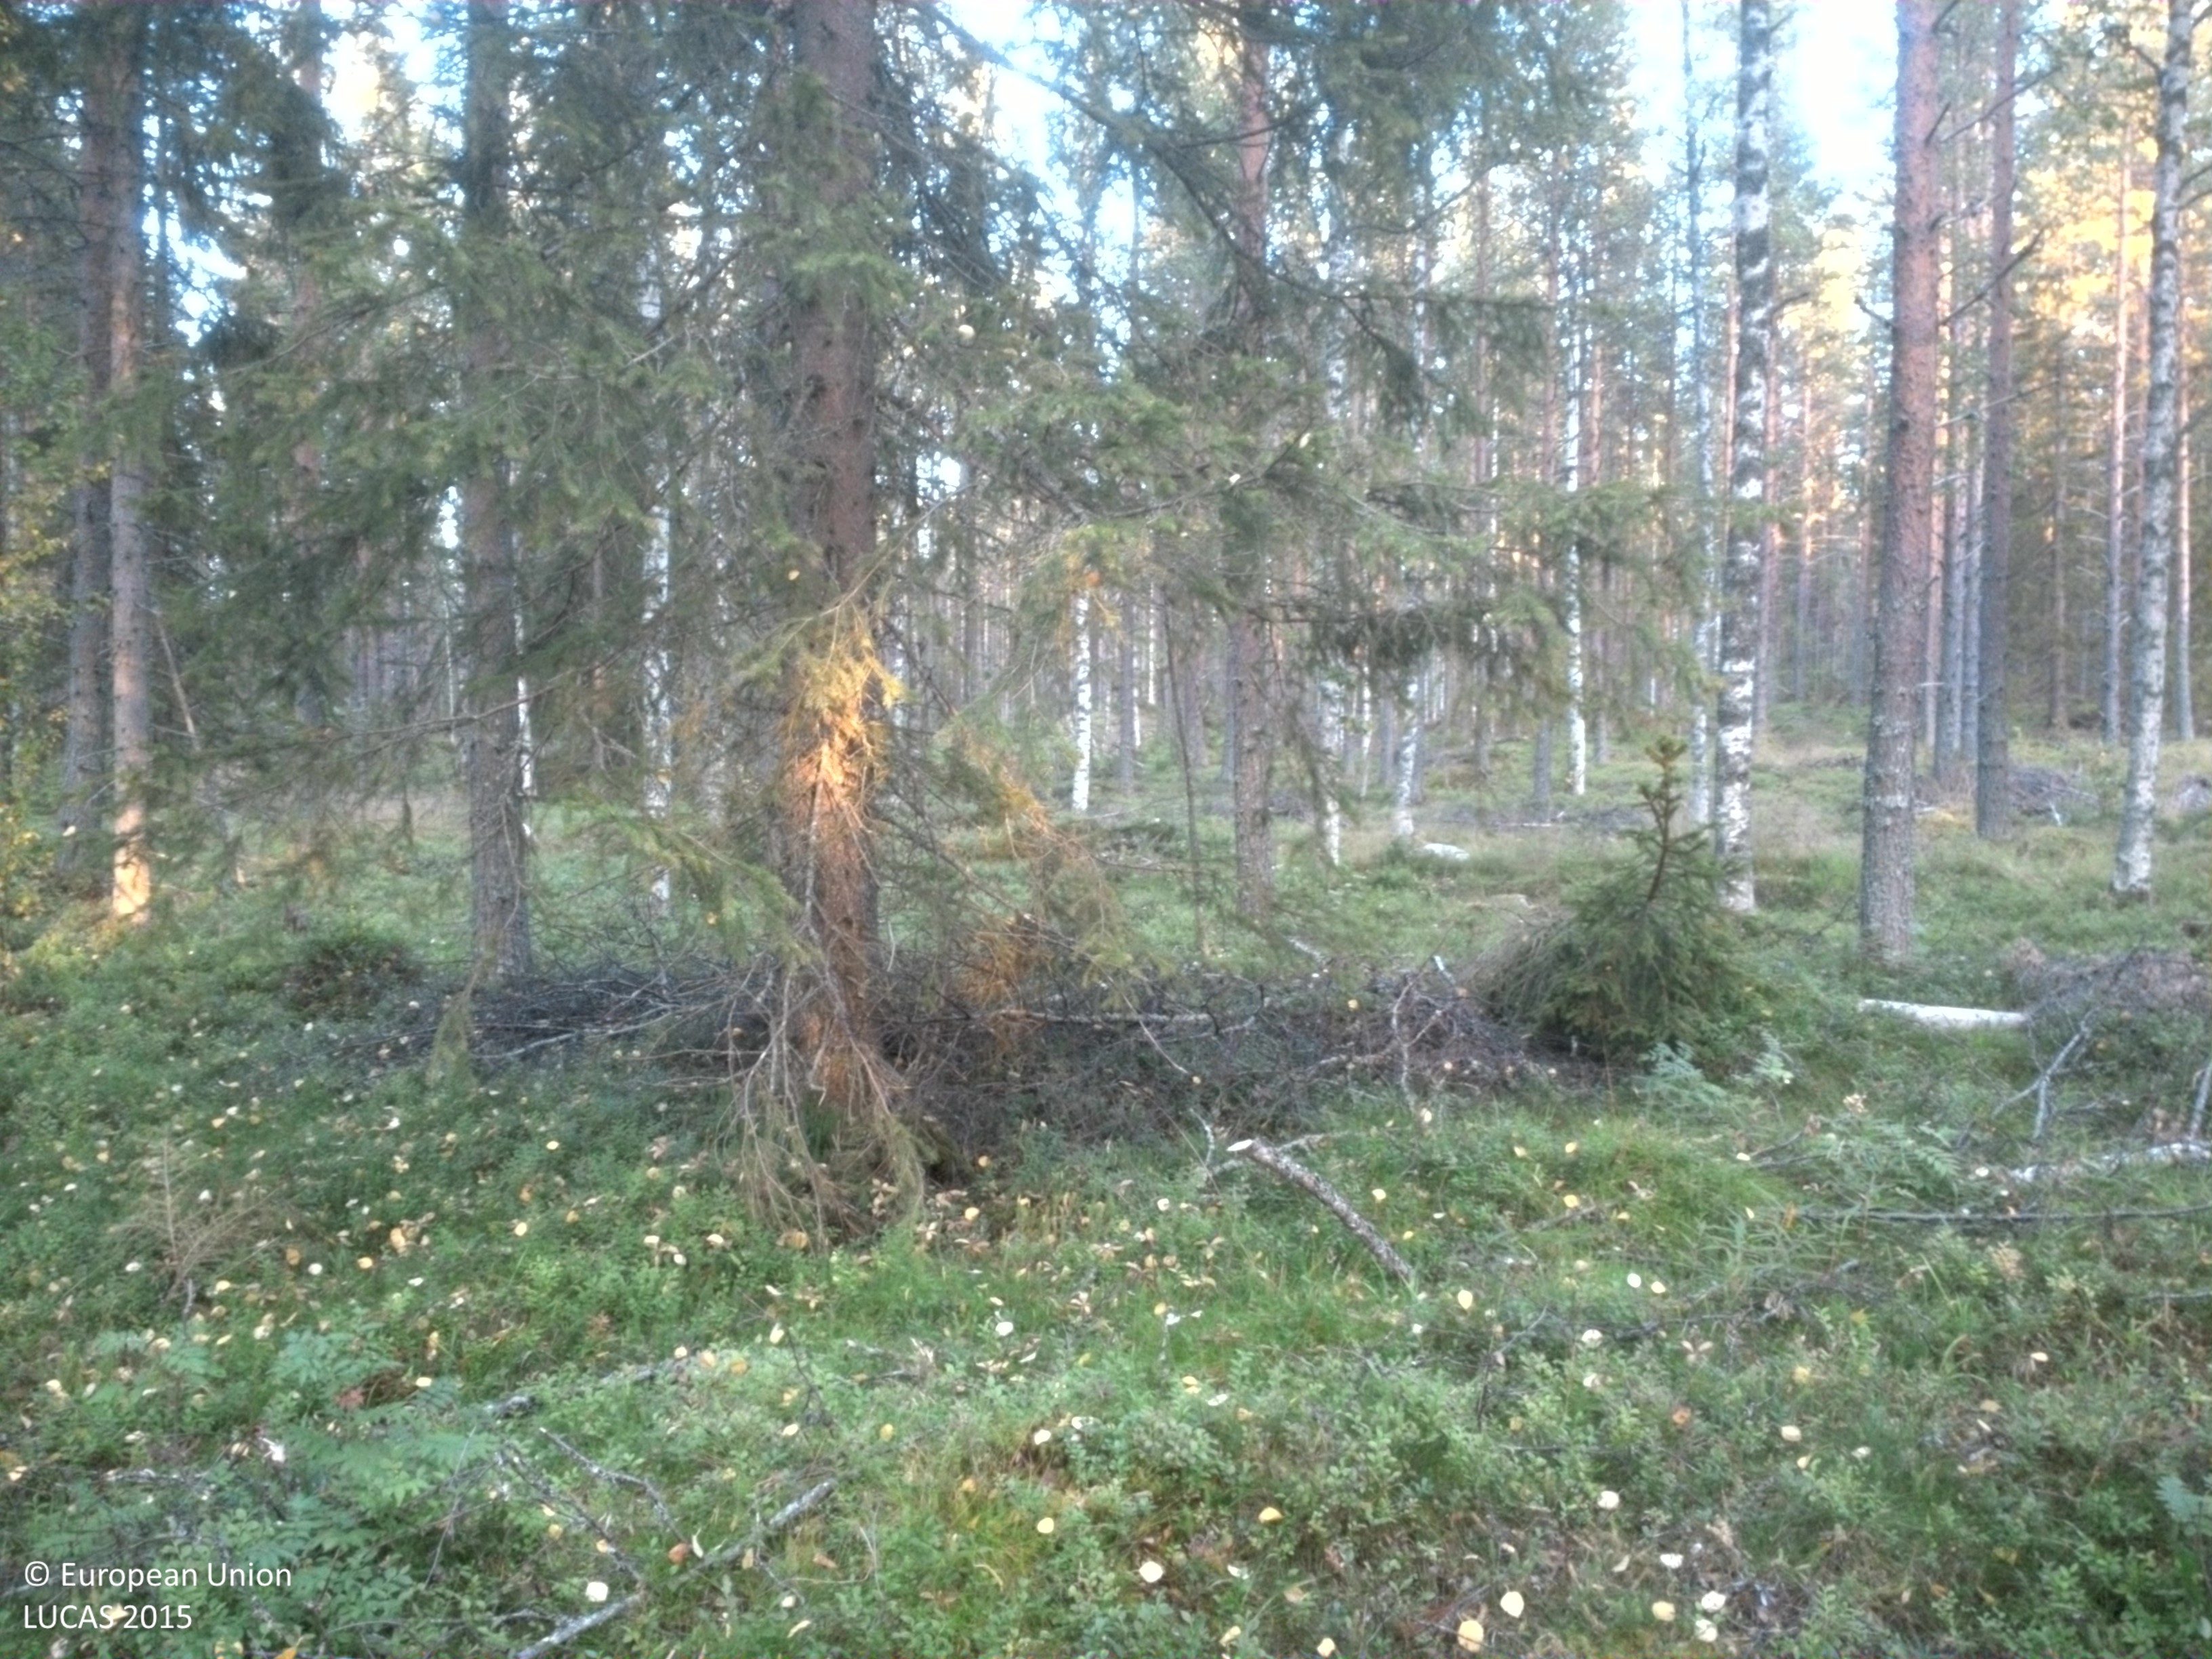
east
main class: Woodland
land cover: Pine dominated coniferous woodland
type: boreal forest
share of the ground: 25 - 50 %
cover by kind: coniferous forest trees 45 %, shrubs 45 %, broadleaved forest trees 5 %, lichens and mosses 5 %
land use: Forestry
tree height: > 5 m
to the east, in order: Pine dominated coniferous woodland; Tracks; Pine dominated mixed woodland; Pine dominated coniferous woodland; Pine dominated mixed woodland; Tracks; Other mixed woodland; Tracks; Other mixed woodland
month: September
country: SE
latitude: 64.3566
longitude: 19.6867
